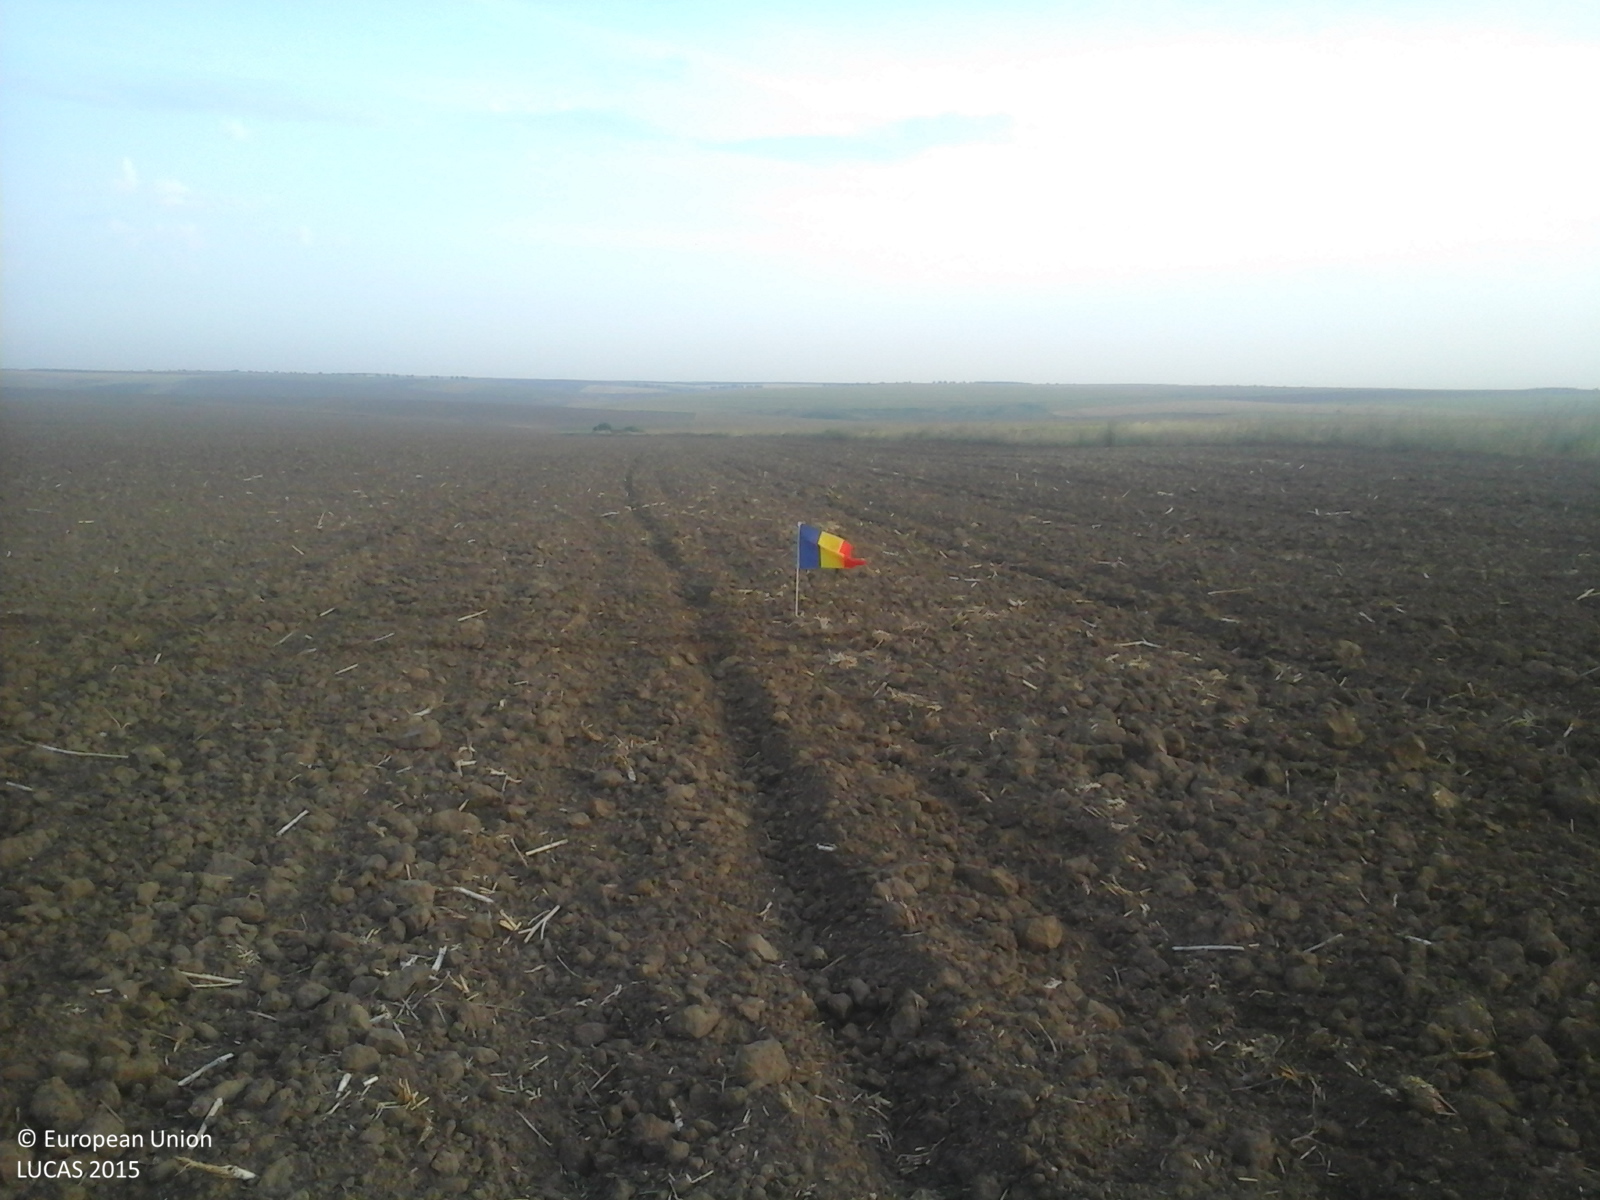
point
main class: Cropland
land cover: Rape and turnip rape
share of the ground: < 10 %
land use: Agriculture (excluding fallow land and kitchen gardens)
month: August
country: RO
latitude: 44.1235
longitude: 28.1149
